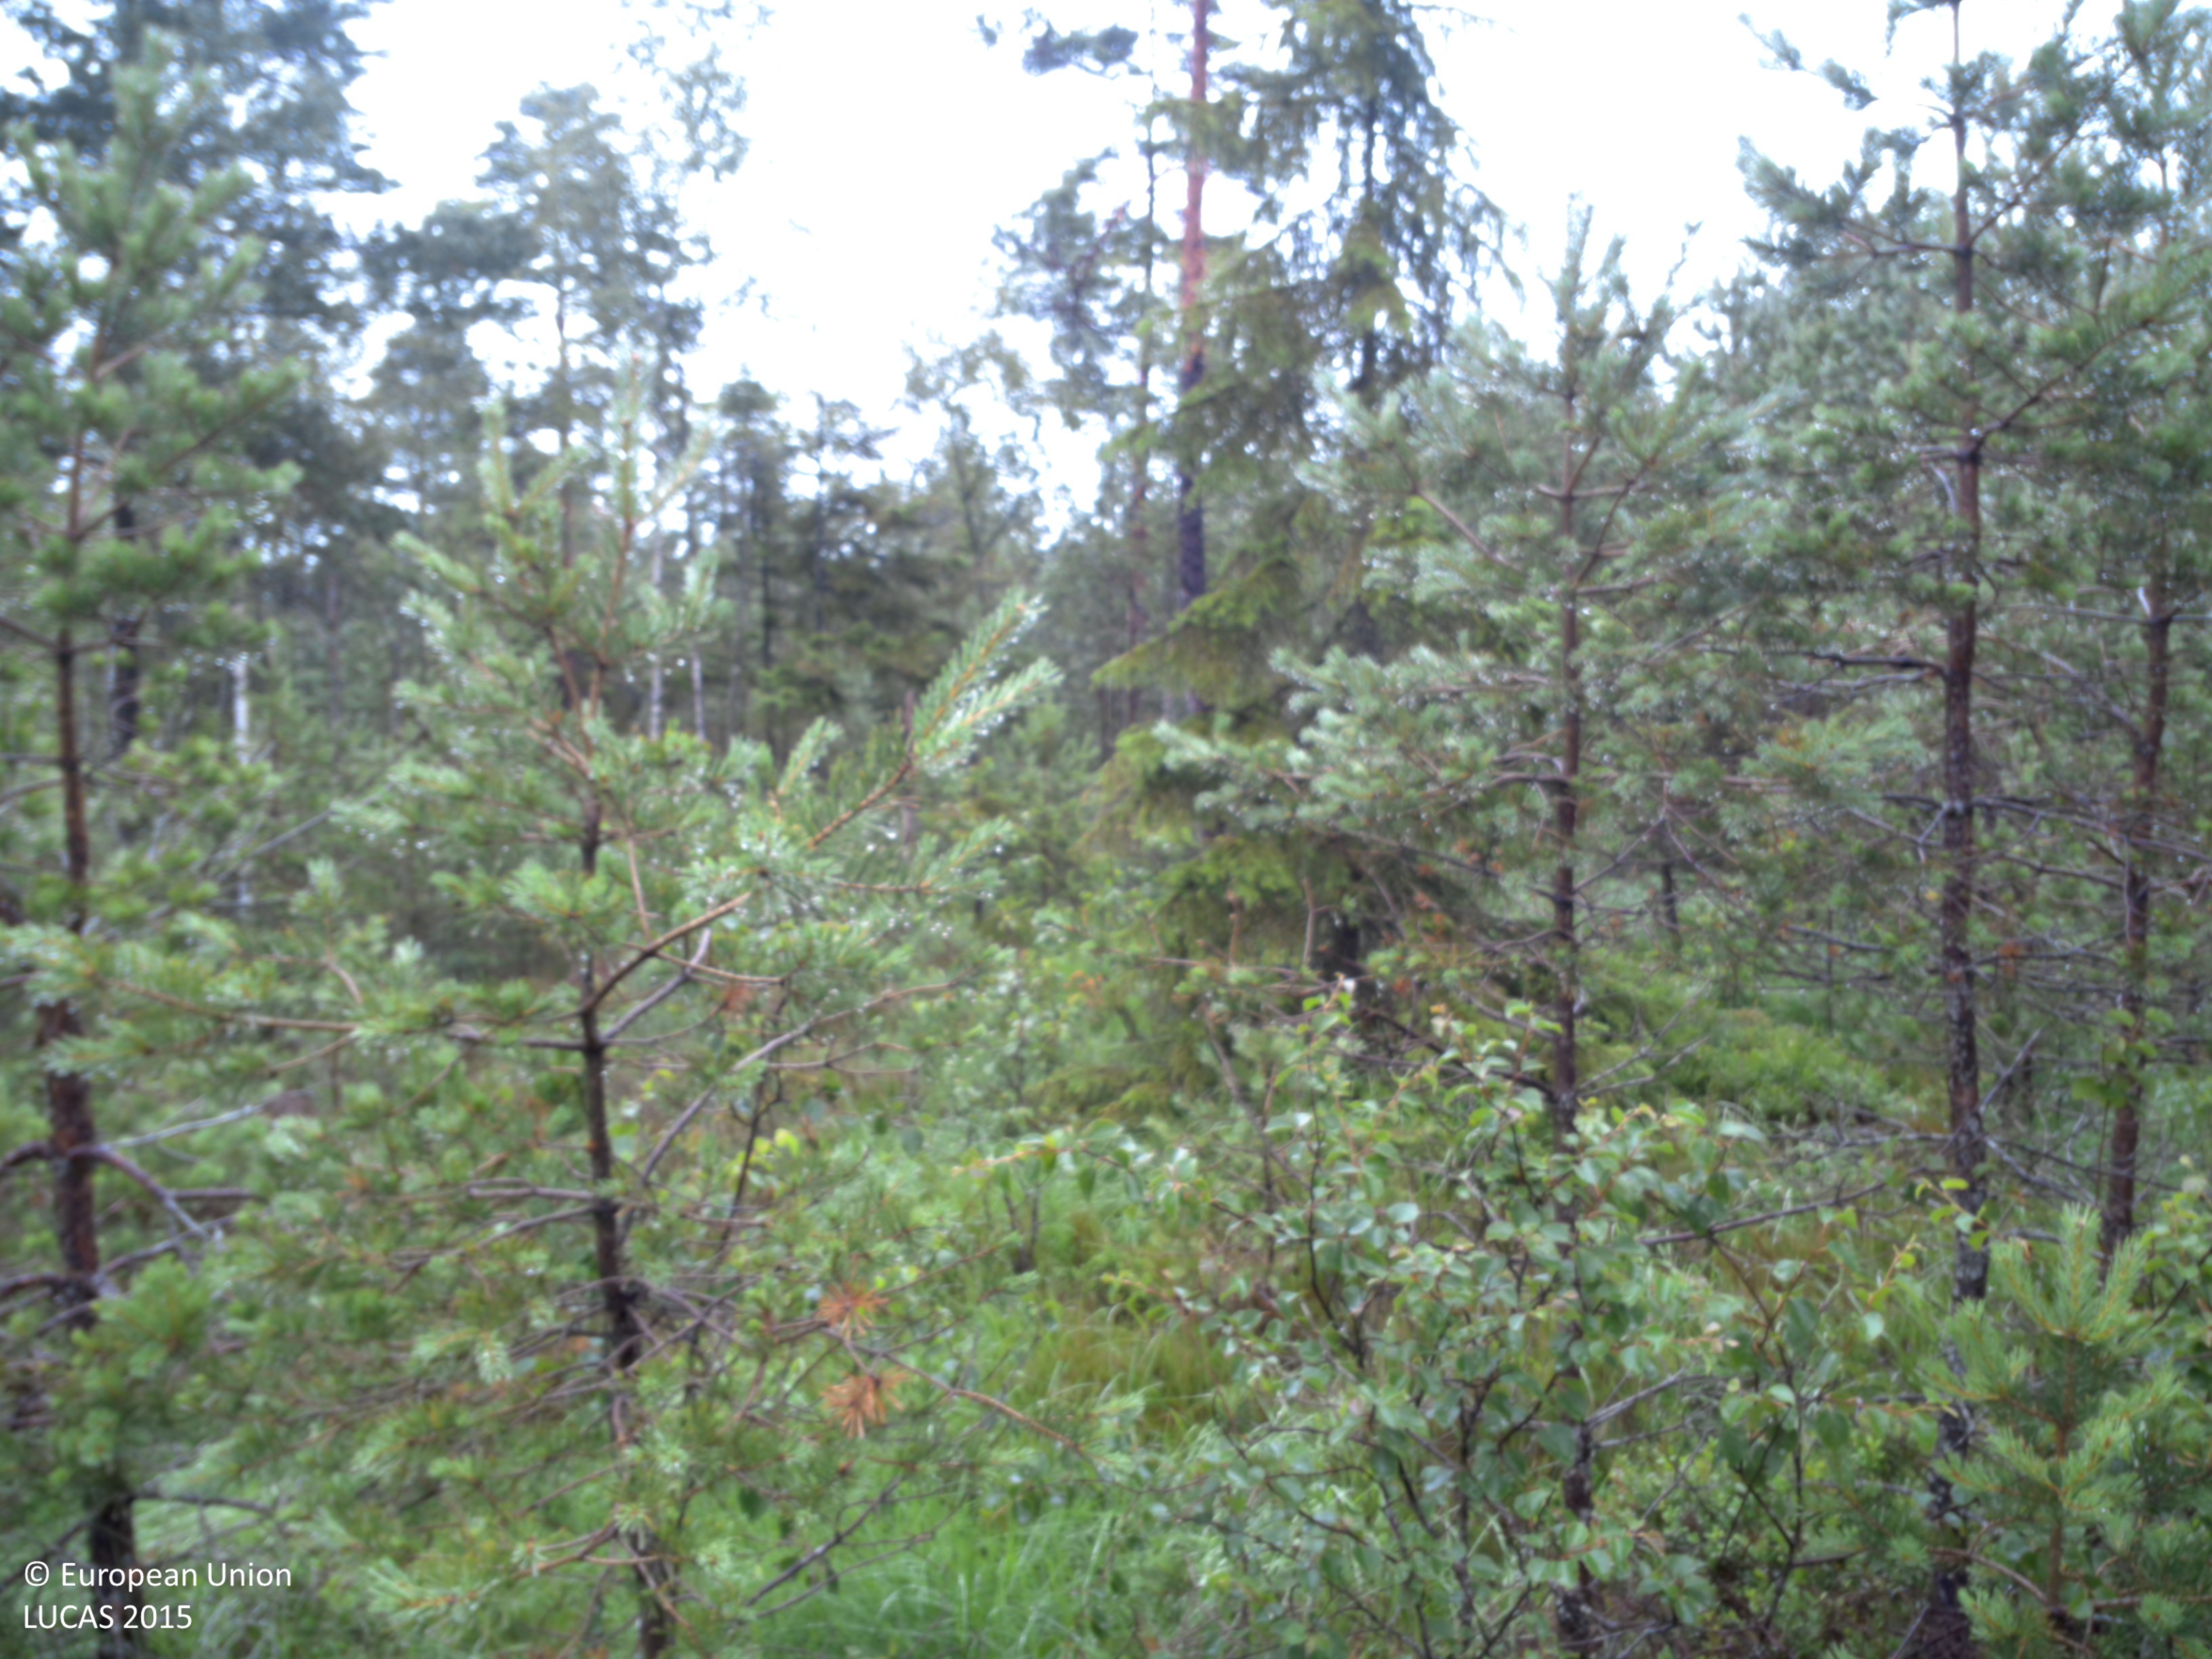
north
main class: Woodland
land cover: Pine dominated mixed woodland
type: boreal forest
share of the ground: 50 - 75 %
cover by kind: coniferous forest trees 40 %, herbaceous plants 30 %, broadleaved forest trees 15 %, shrubs 15 %
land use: Forestry
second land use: Amenities, museums, leisure
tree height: < 5 m
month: July
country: SE
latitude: 58.6944
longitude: 11.7044
